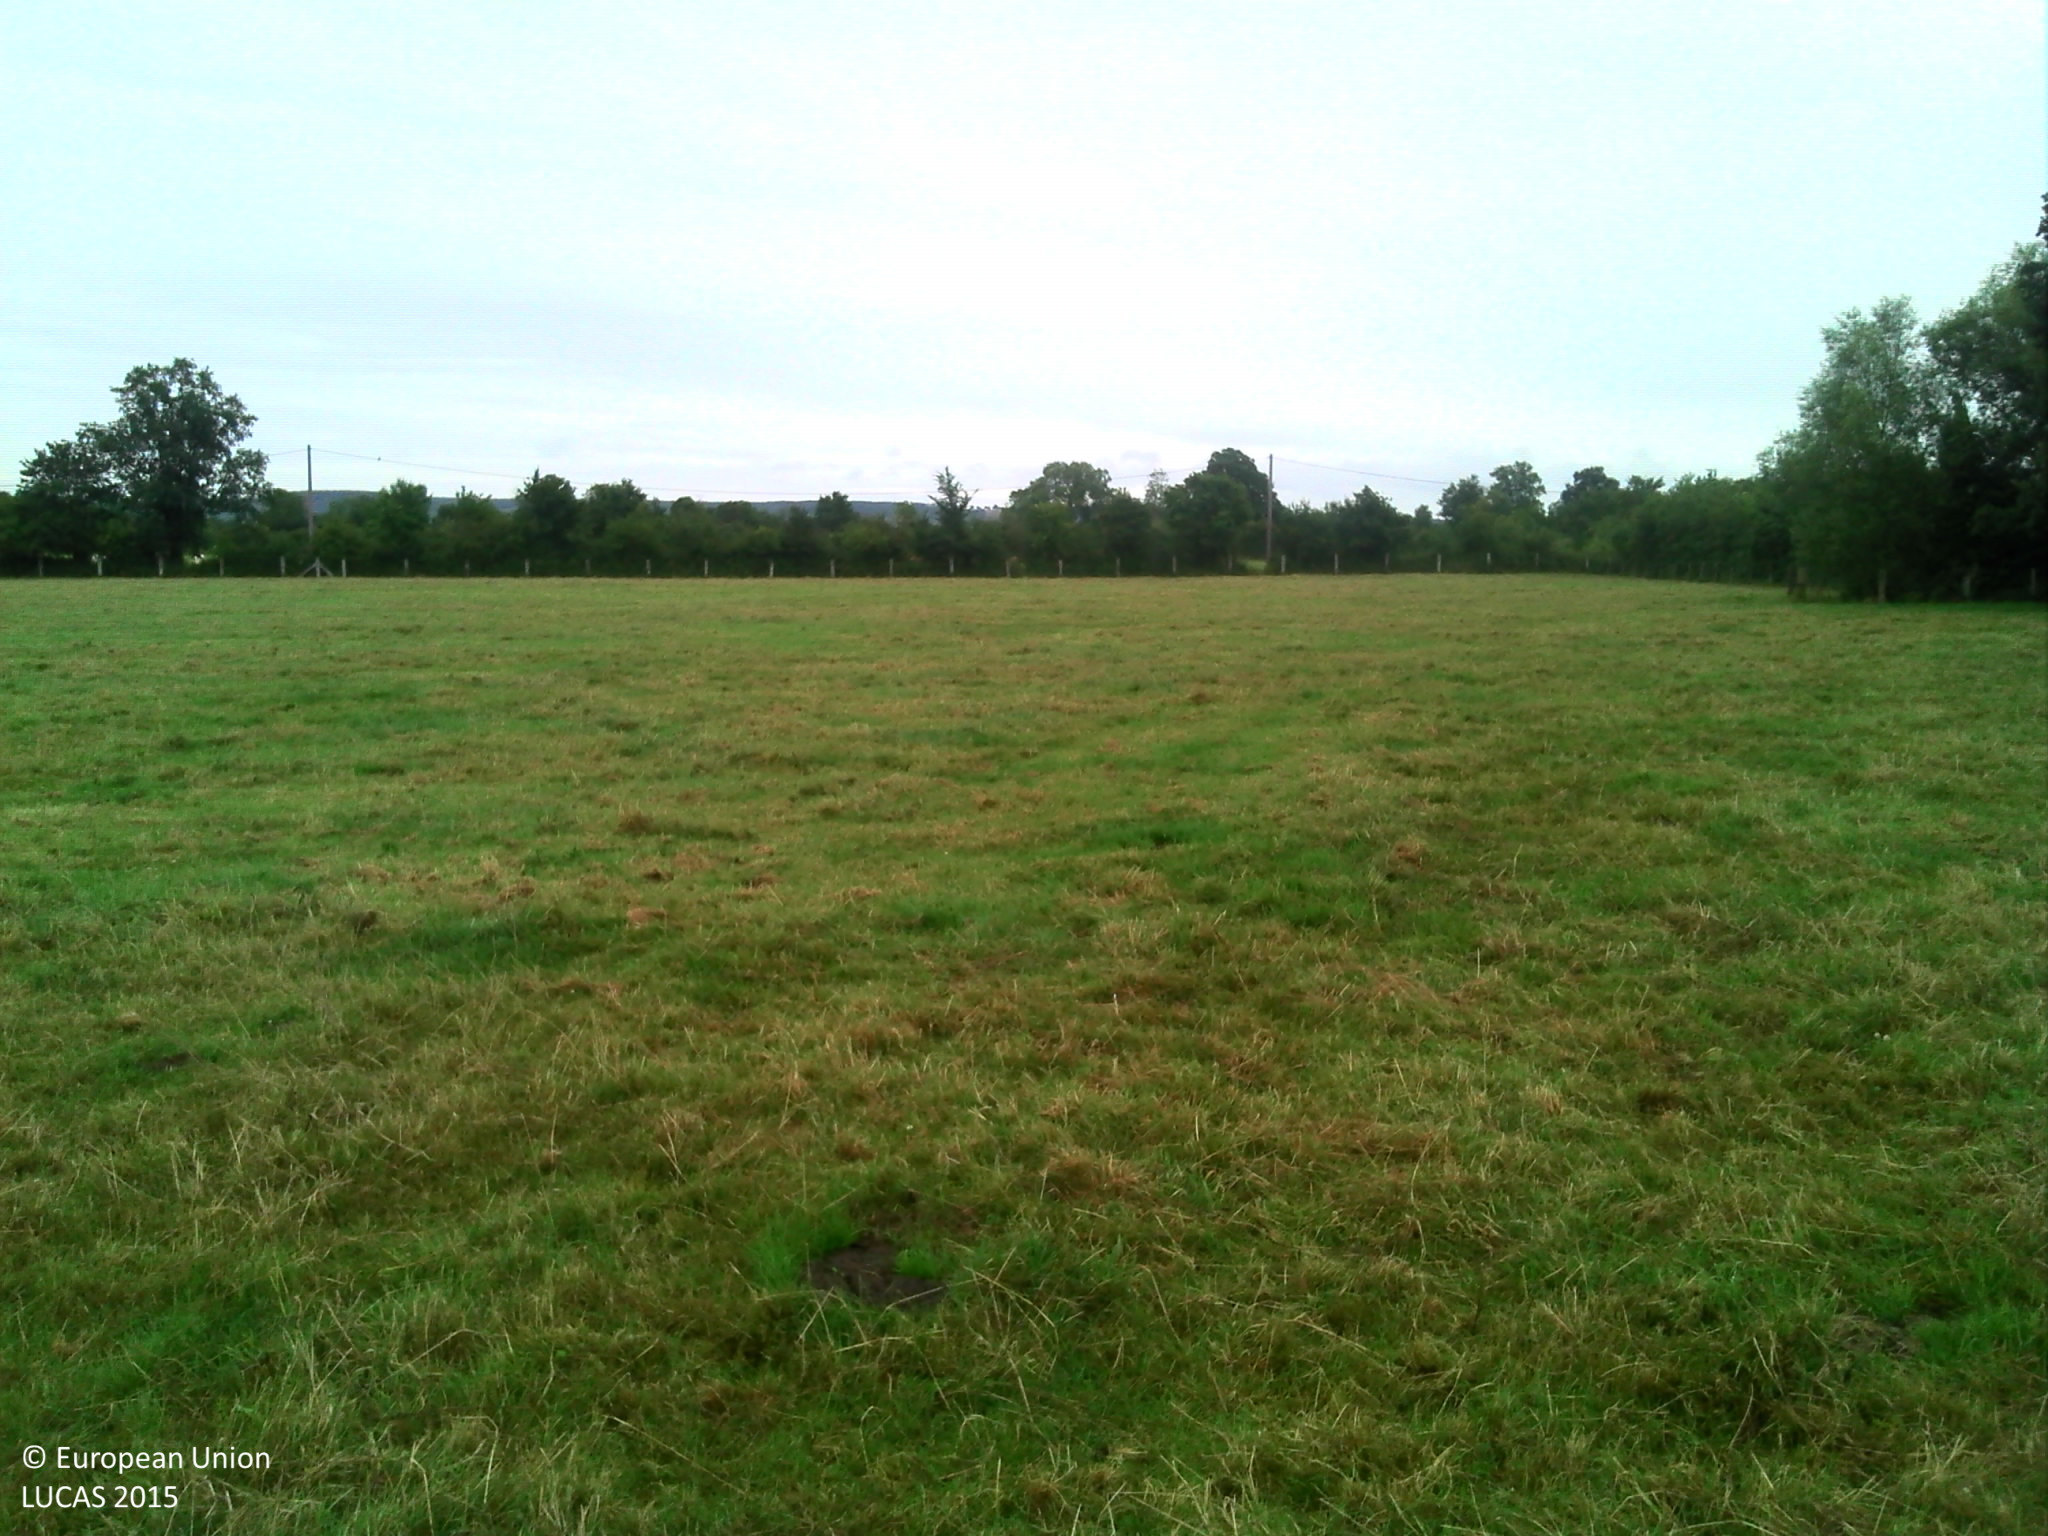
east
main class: Grassland
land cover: Grassland without tree/shrub cover
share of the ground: > 75 %
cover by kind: herbaceous plants 100 %
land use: Agriculture (excluding fallow land and kitchen gardens)
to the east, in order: Grassland without tree/shrub cover; Fences; Managed hedges; Fences; Electric lines; Grassland without tree/shrub cover
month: July
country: FR
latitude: 49.1101
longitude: 0.0099
